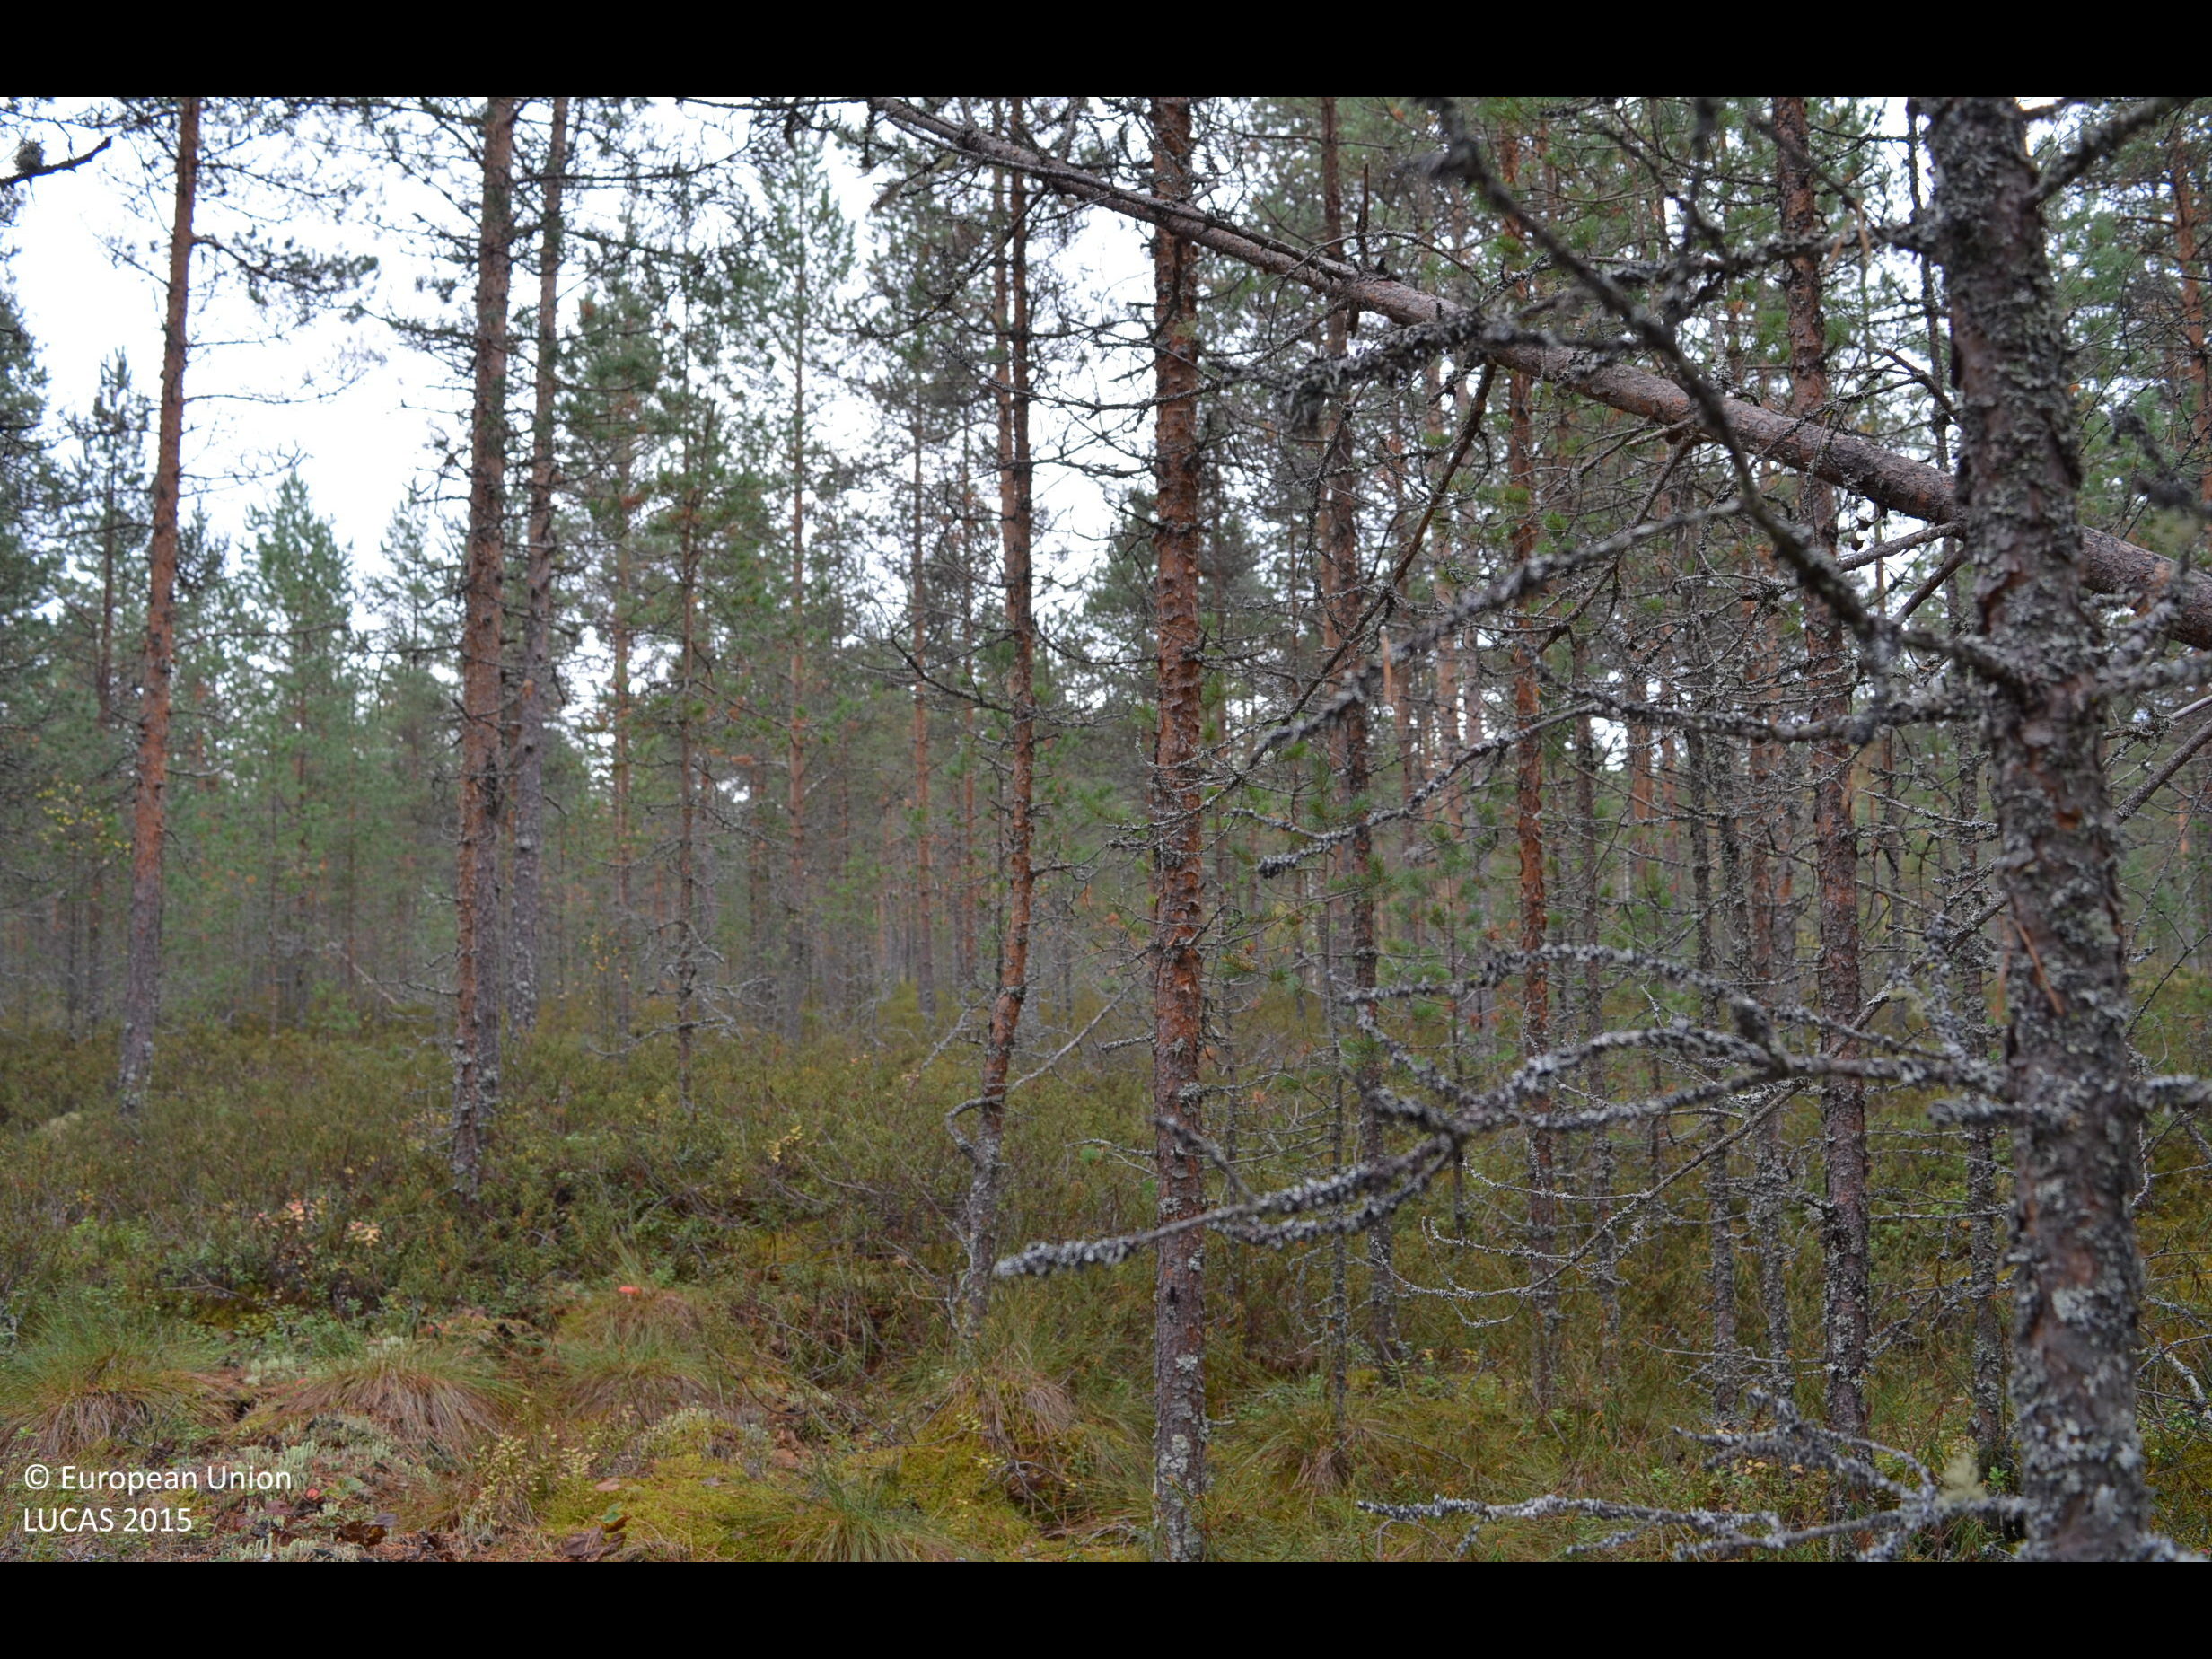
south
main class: Woodland
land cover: Pine dominated coniferous woodland
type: mire and swamp forests
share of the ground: 50 - 75 %
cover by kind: coniferous forest trees 65 %, shrubs 25 %, herbaceous plants 5 %, lichens and mosses 5 %
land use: Forestry
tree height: > 5 m
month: October
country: FI
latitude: 62.3883
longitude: 23.4744
